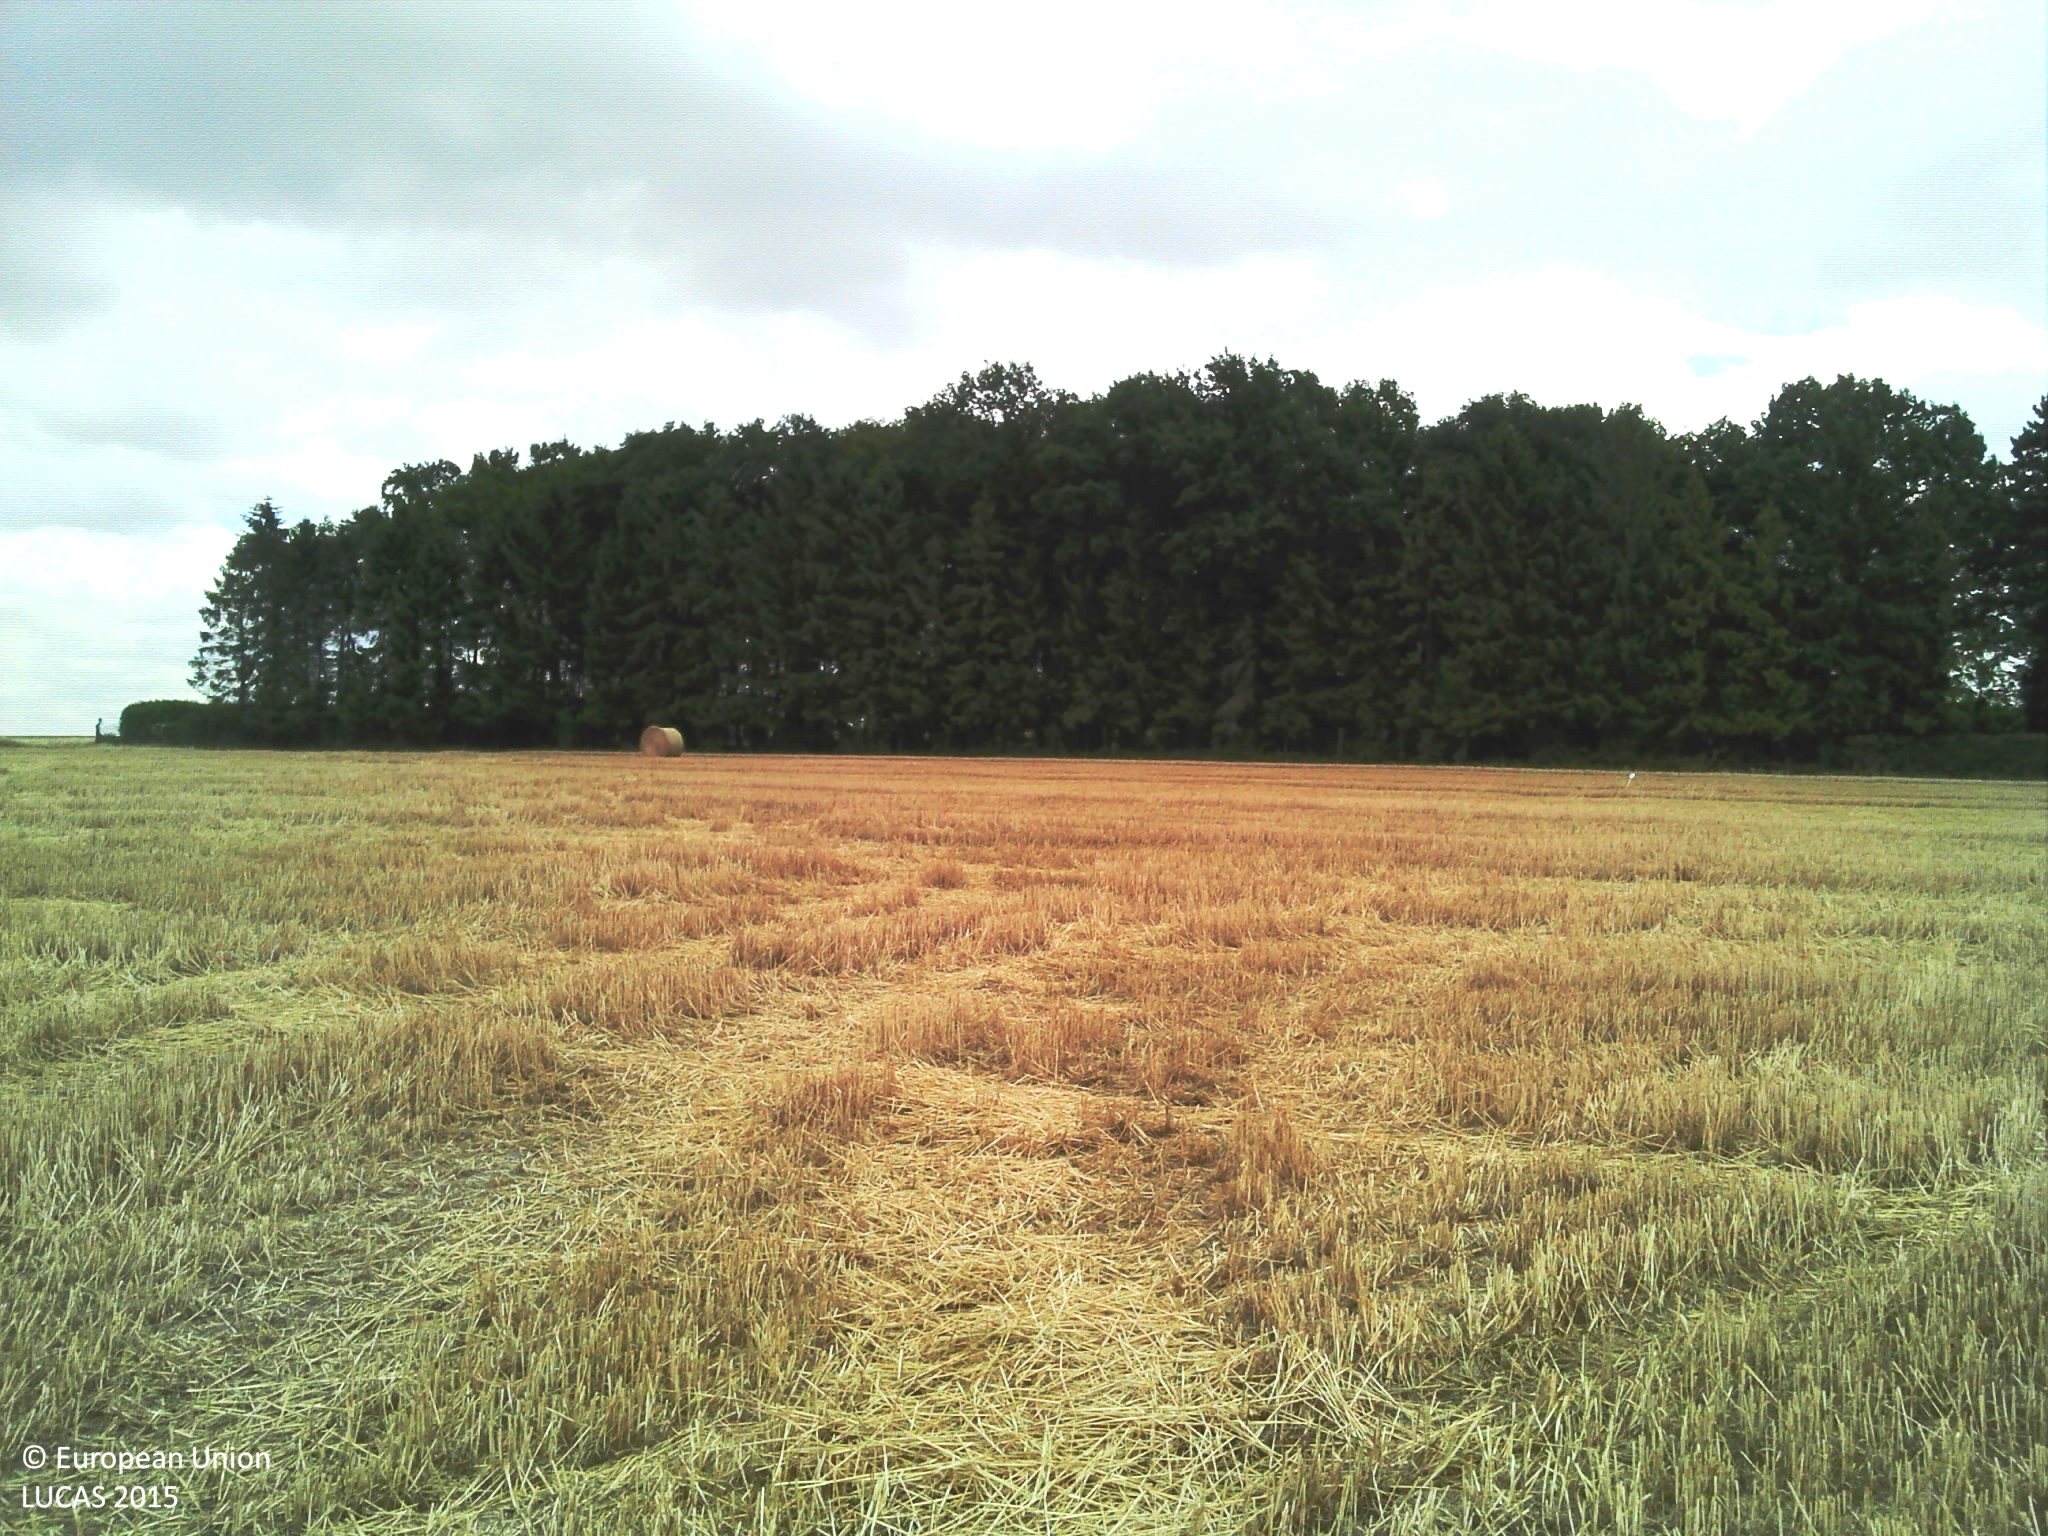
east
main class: Cropland
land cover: Common wheat
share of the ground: > 75 %
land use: Agriculture (excluding fallow land and kitchen gardens)
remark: Harvested field
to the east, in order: Common wheat; Grass margins; Fences; Spruce dominated mixed woodland; Managed hedges; Fences; Grass margins; Ditches and canals; Grass margins; Paved roads, cycling and walking lanes; Electric lines; Grass margins; Ditches and canals; Common wheat
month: July
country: FR
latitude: 49.1883
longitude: 2.6485
